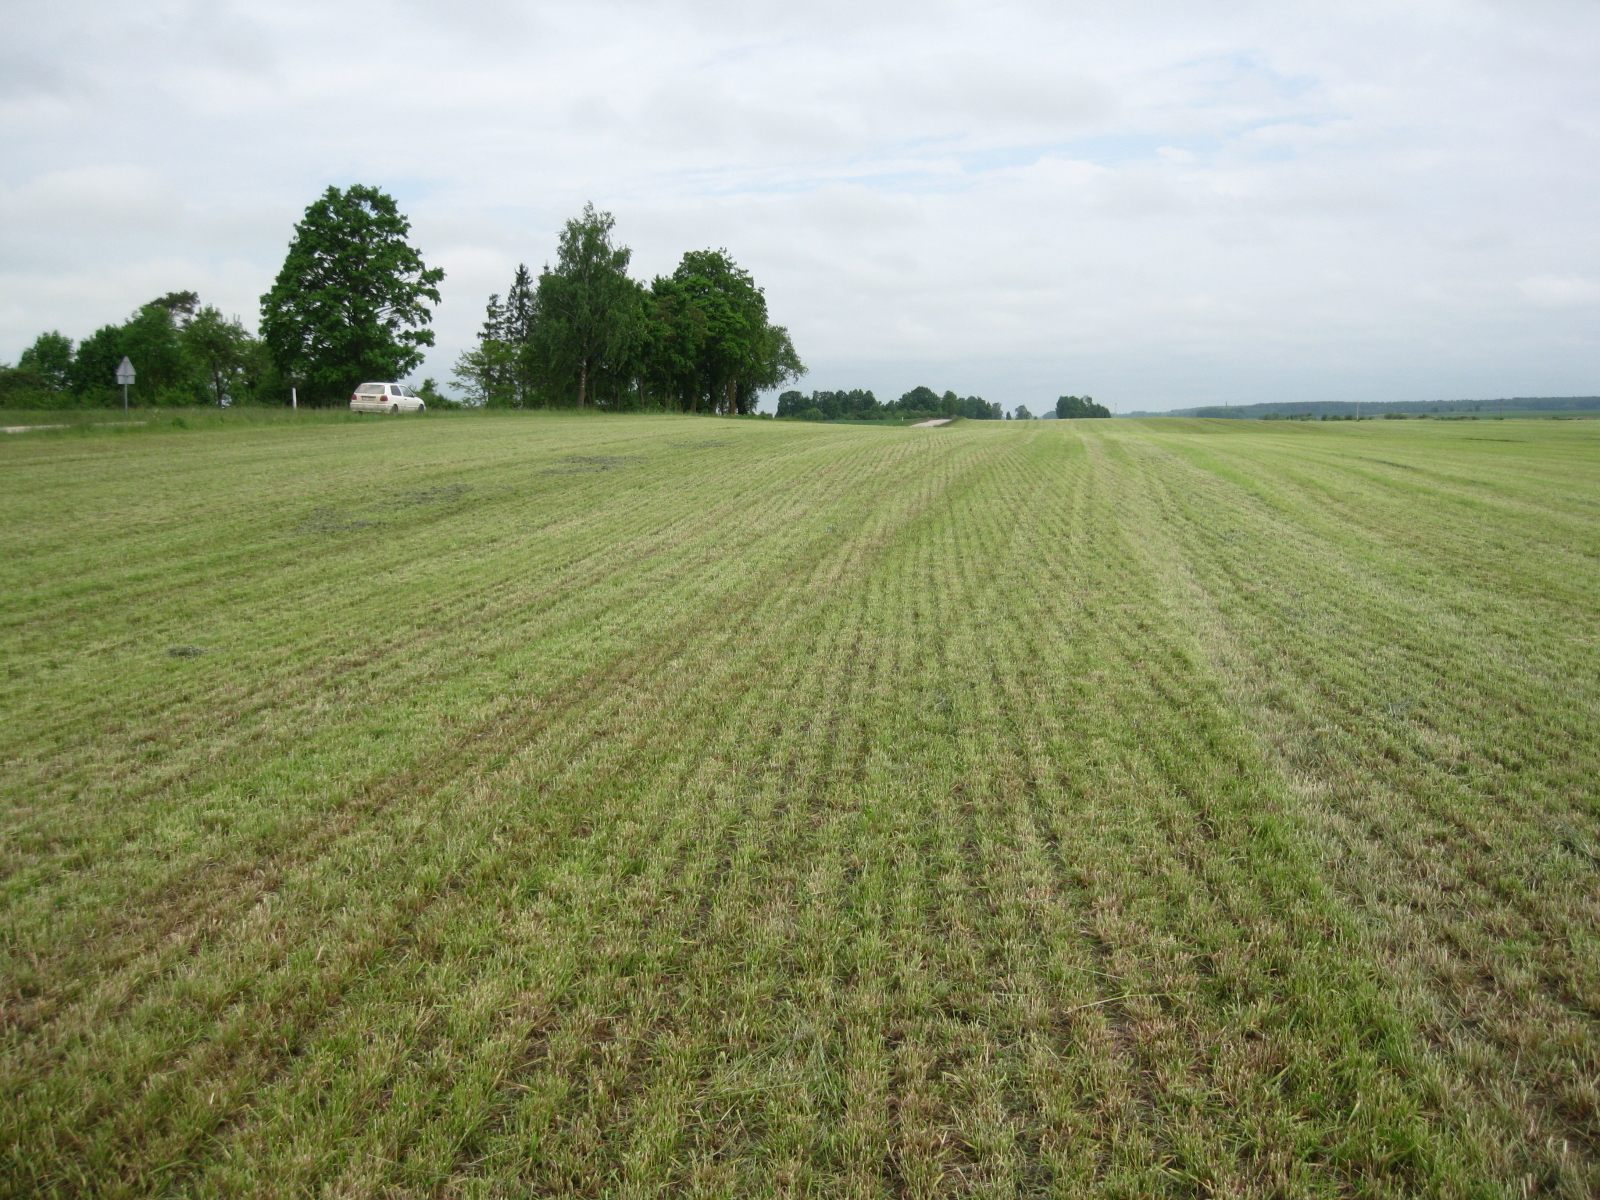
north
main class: Cropland
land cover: Temporary grasslands
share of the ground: > 75 %
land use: Agriculture (excluding fallow land and kitchen gardens)
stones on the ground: < 10 %
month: June
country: LT
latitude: 55.9485
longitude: 24.1341
